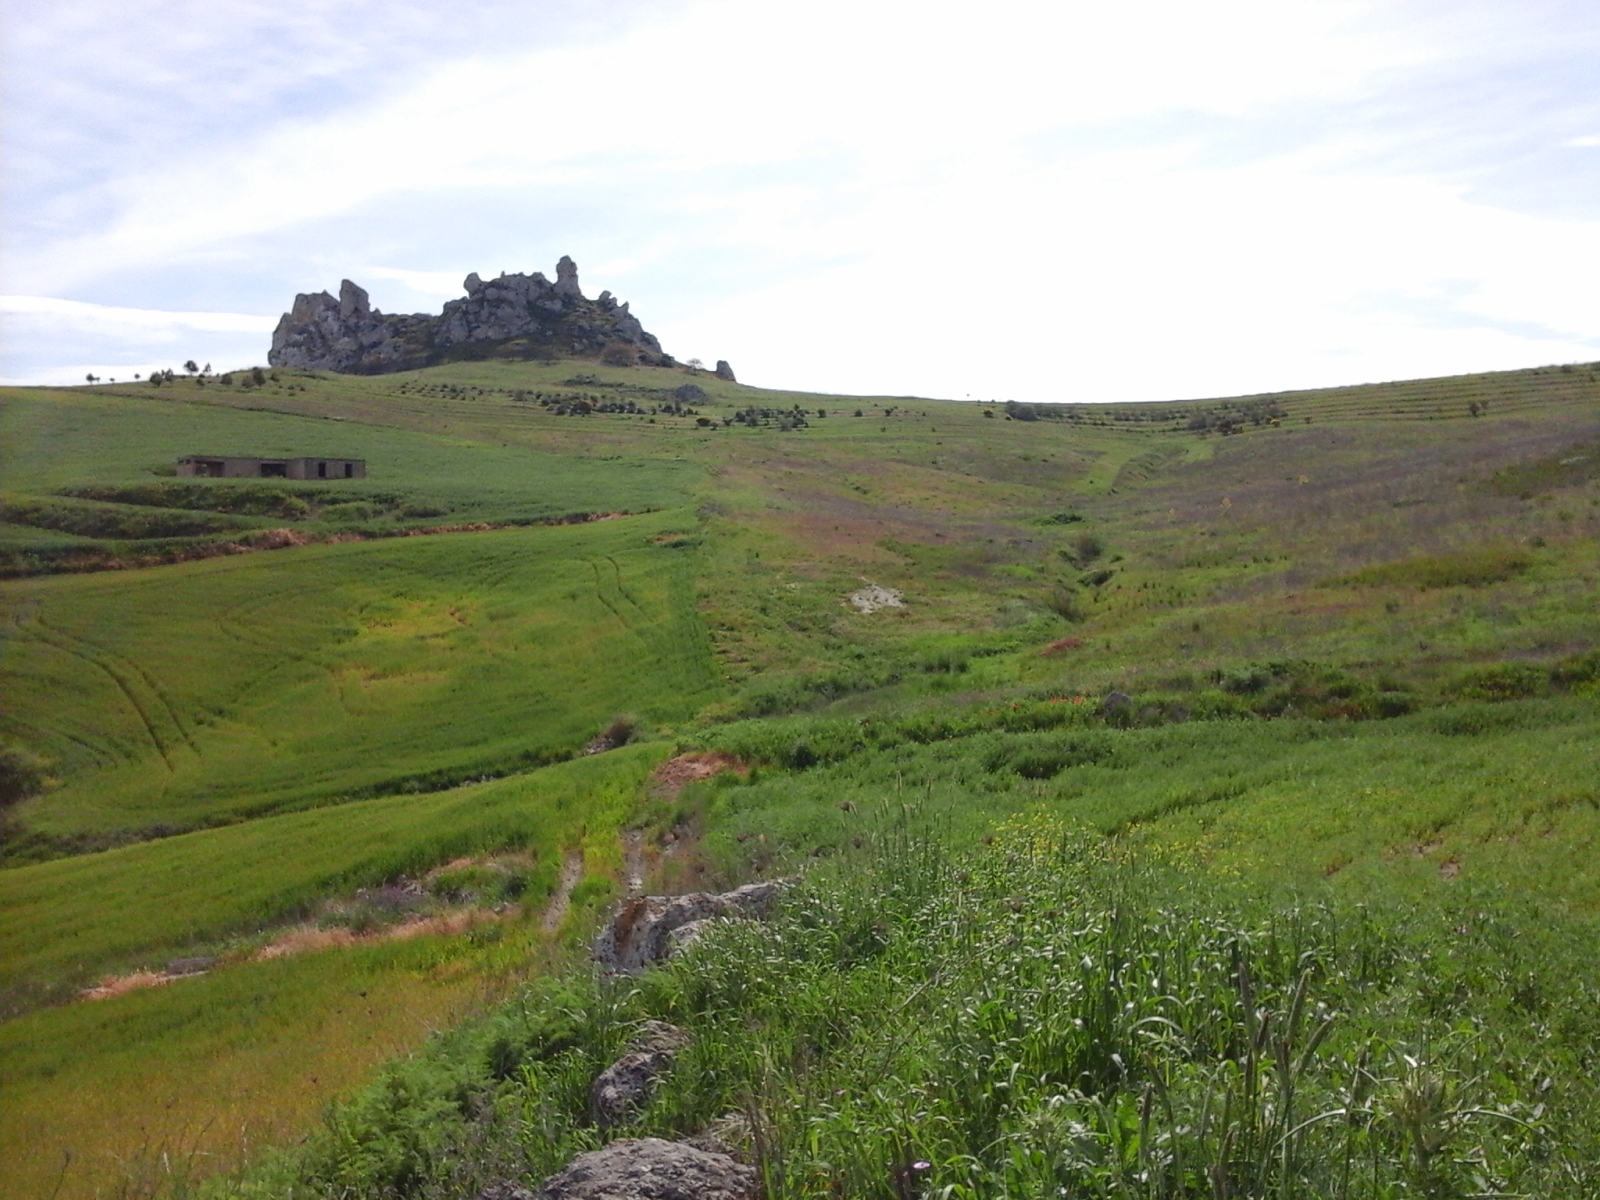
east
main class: Cropland
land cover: Other leguminous and mixtures for fodder
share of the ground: > 75 %
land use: Agriculture (excluding fallow land and kitchen gardens)
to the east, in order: Other leguminous and mixtures for fodder; Grassland without tree/shrub cover; Ditches and canals; Grassland without tree/shrub cover
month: May
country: IT
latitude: 37.4403
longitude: 14.1170
